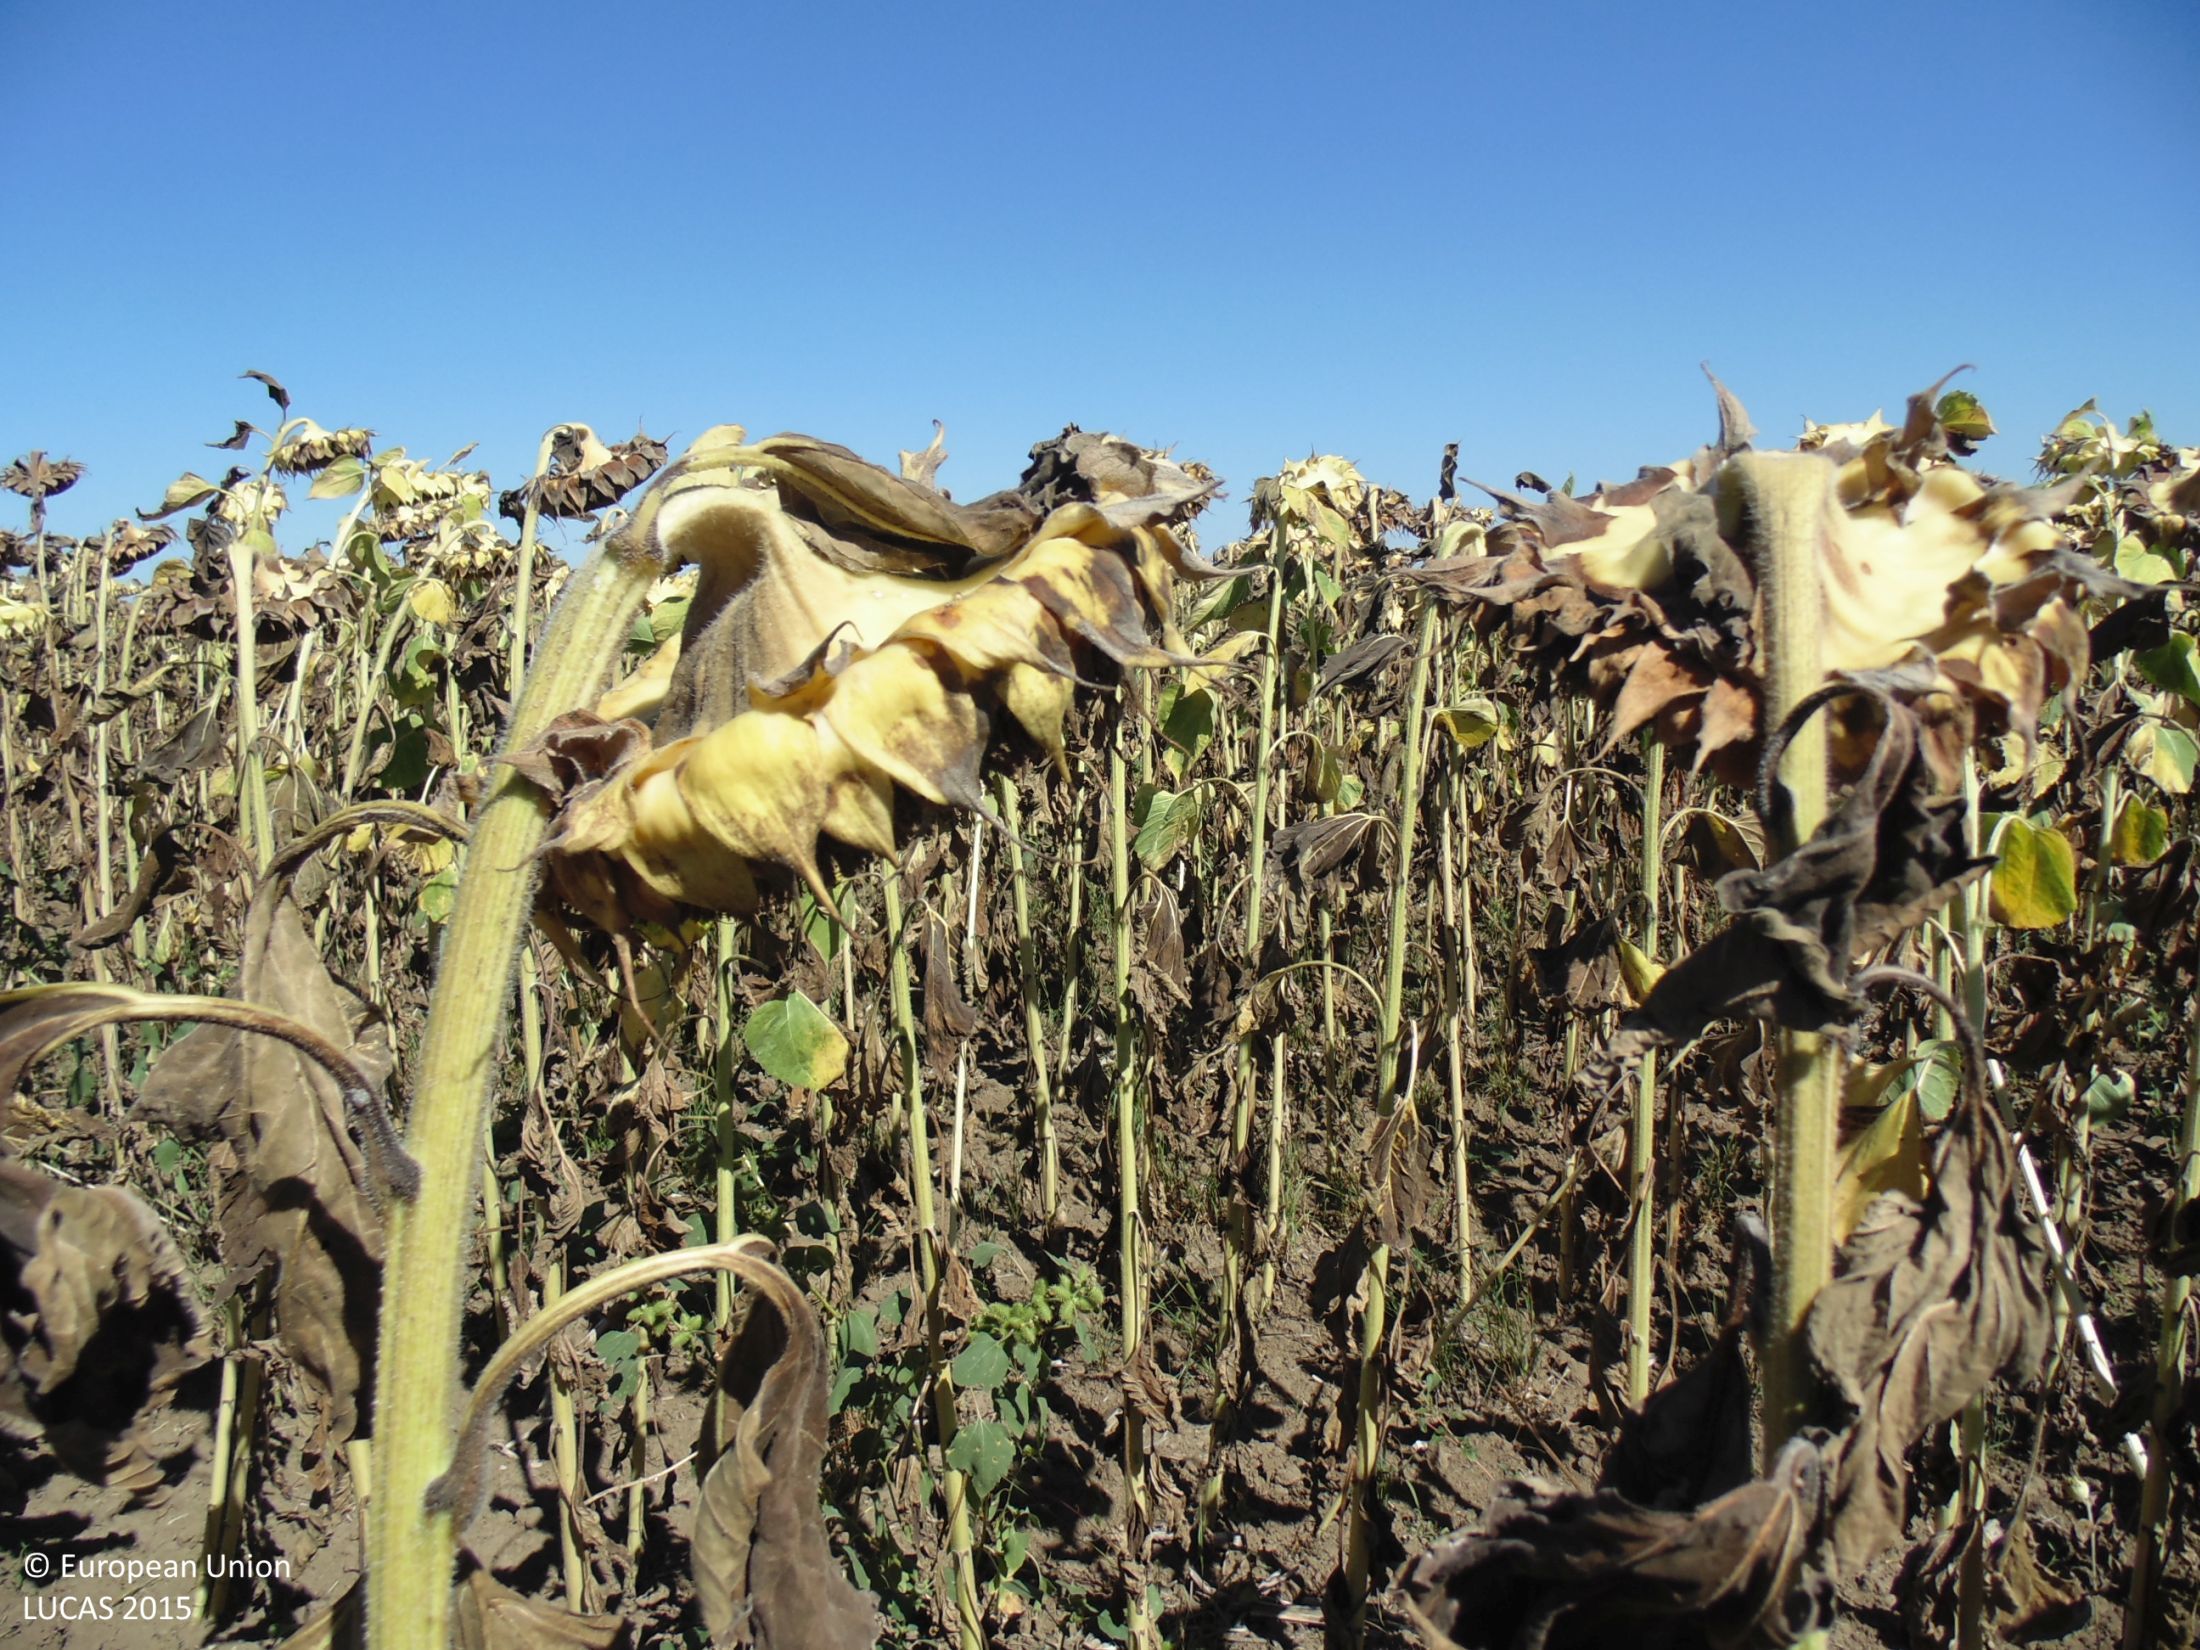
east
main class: Cropland
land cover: Sunflower
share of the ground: > 75 %
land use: Agriculture (excluding fallow land and kitchen gardens)
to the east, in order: Sunflower
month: September
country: BG
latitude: 43.8837
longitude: 27.2682
